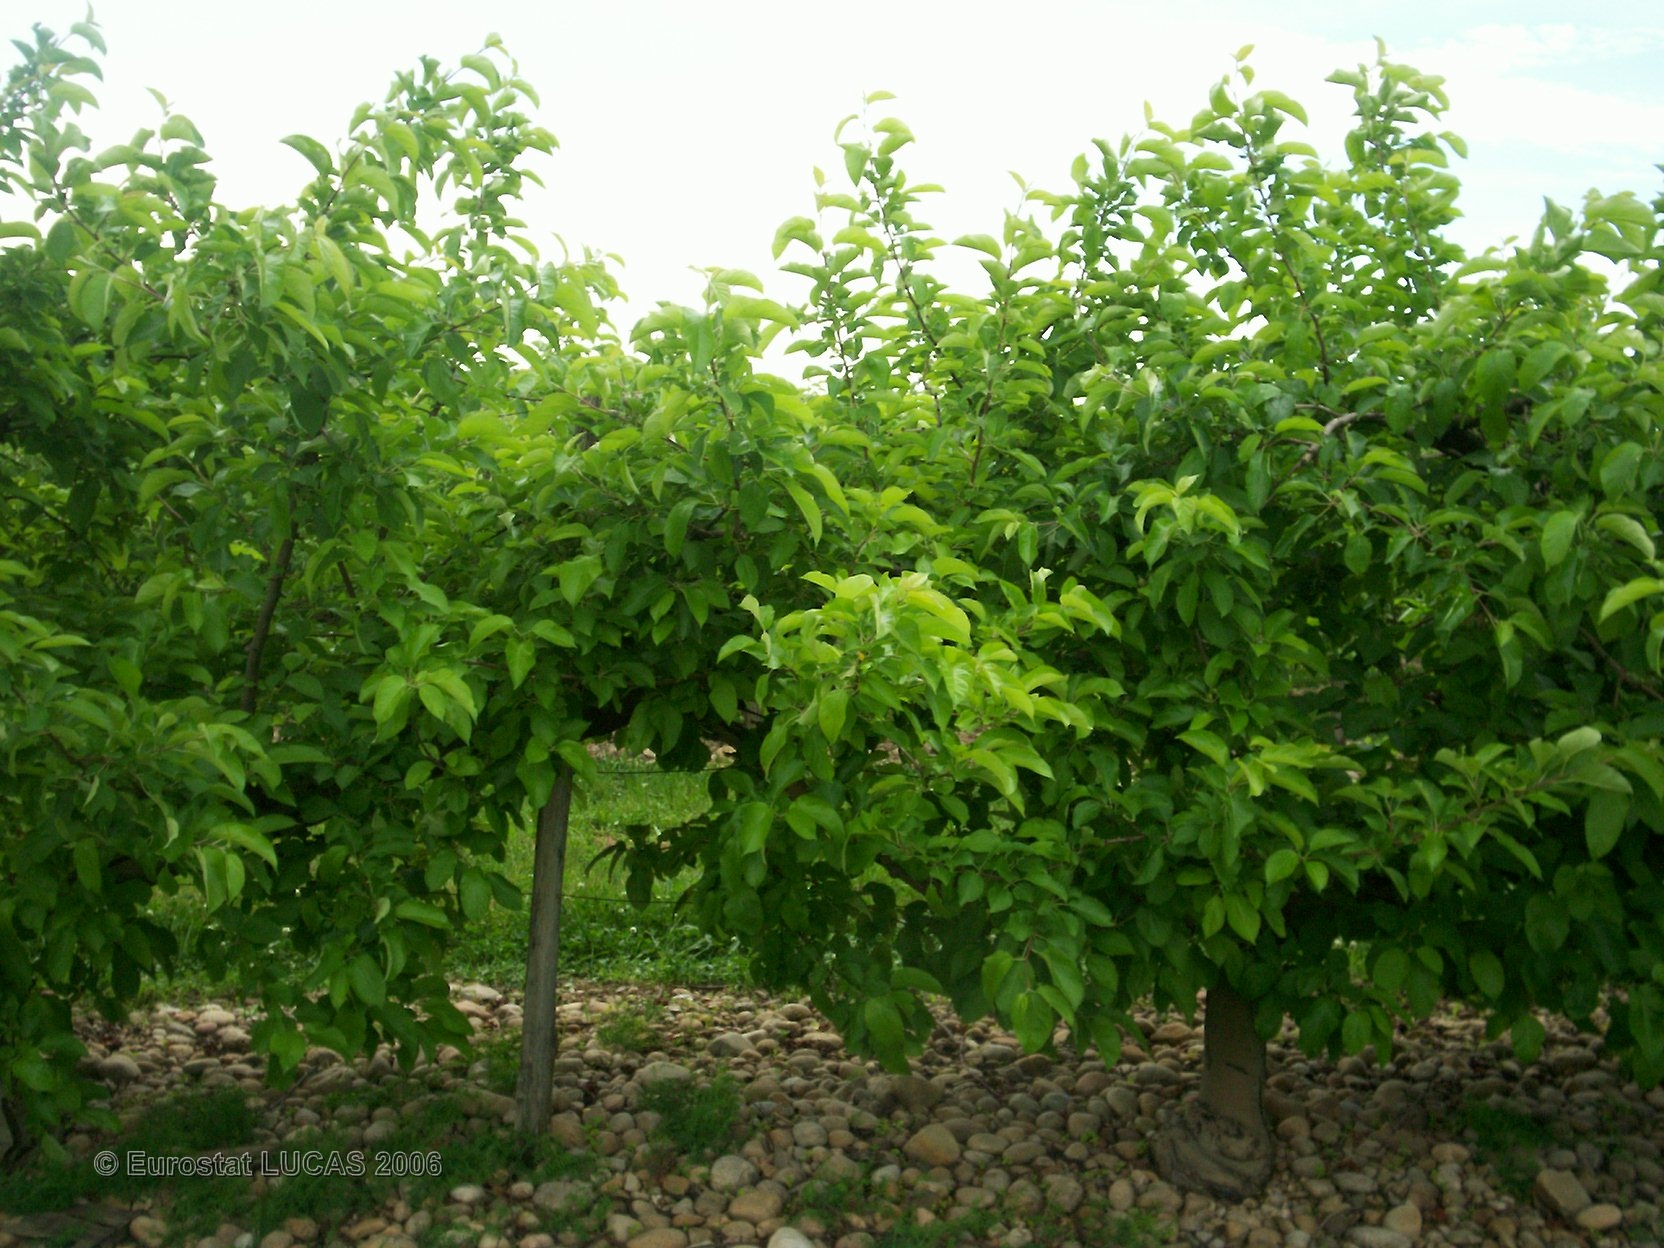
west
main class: Cropland
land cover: Pear fruit
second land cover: Grassland with sparse tree/shrub cover
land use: Agriculture (excluding fallow land and kitchen gardens)
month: May
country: FR
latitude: 45.6450
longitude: 4.7560
